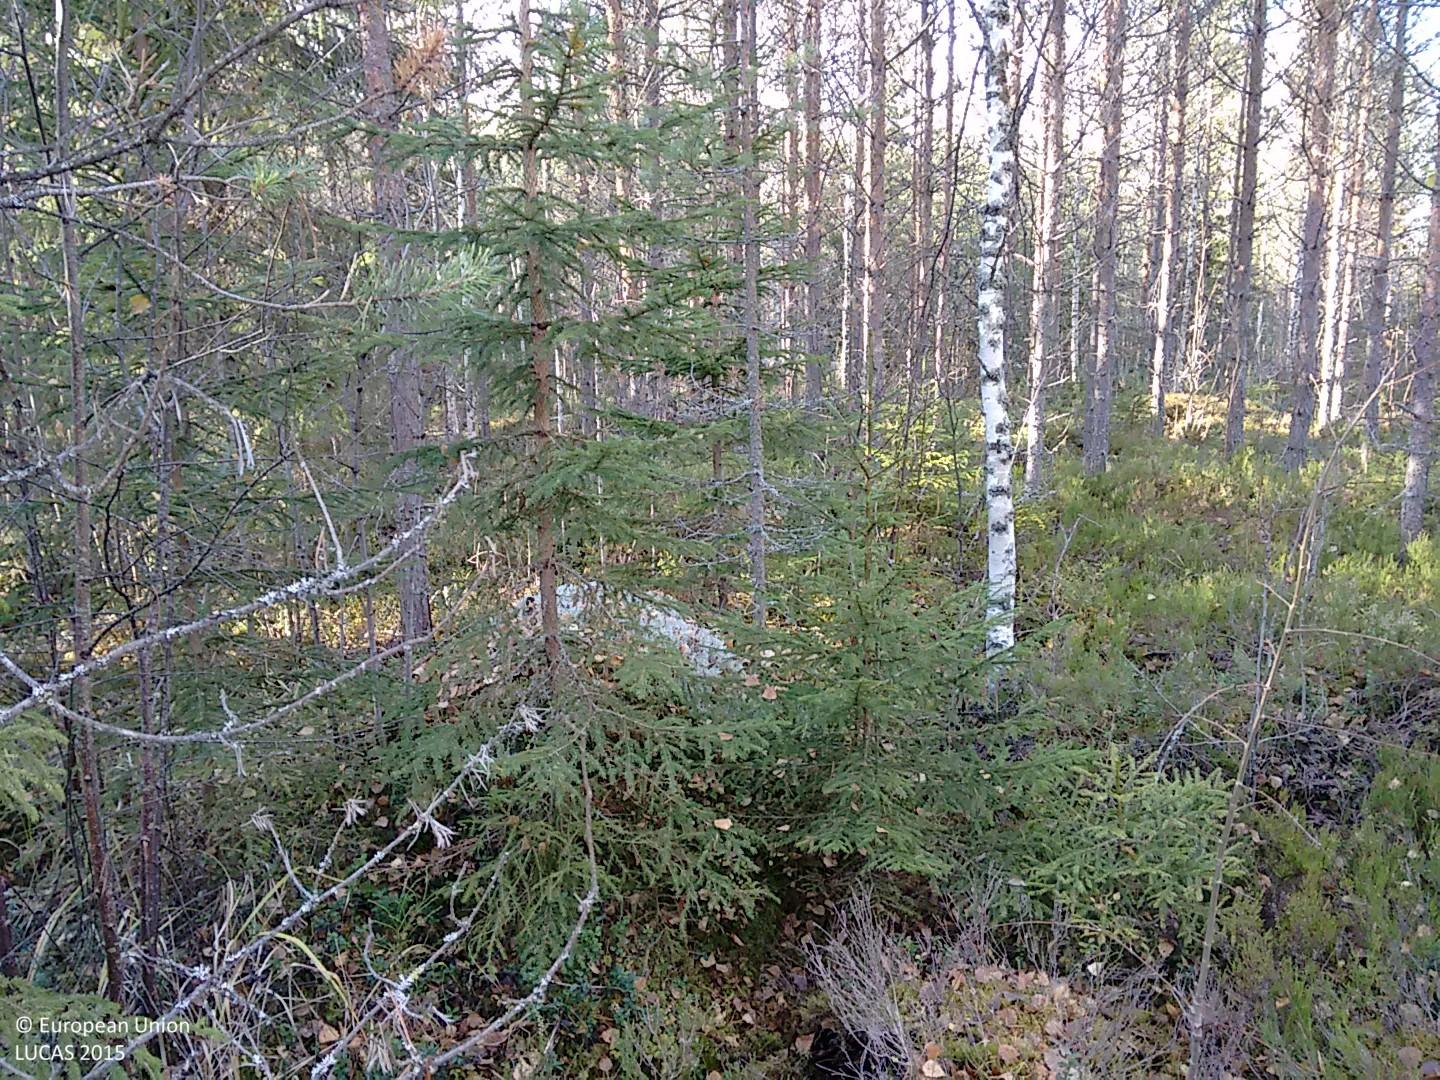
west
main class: Woodland
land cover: Pine dominated mixed woodland
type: hemiboreal forest and nemoral coniferous forest and mixed broadleaved-coniferous forest
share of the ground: > 75 %
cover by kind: coniferous forest trees 55 %, broadleaved forest trees 25 %, shrubs 20 %
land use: Forestry
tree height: > 5 m
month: October
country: FI
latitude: 62.6105
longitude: 25.8832
